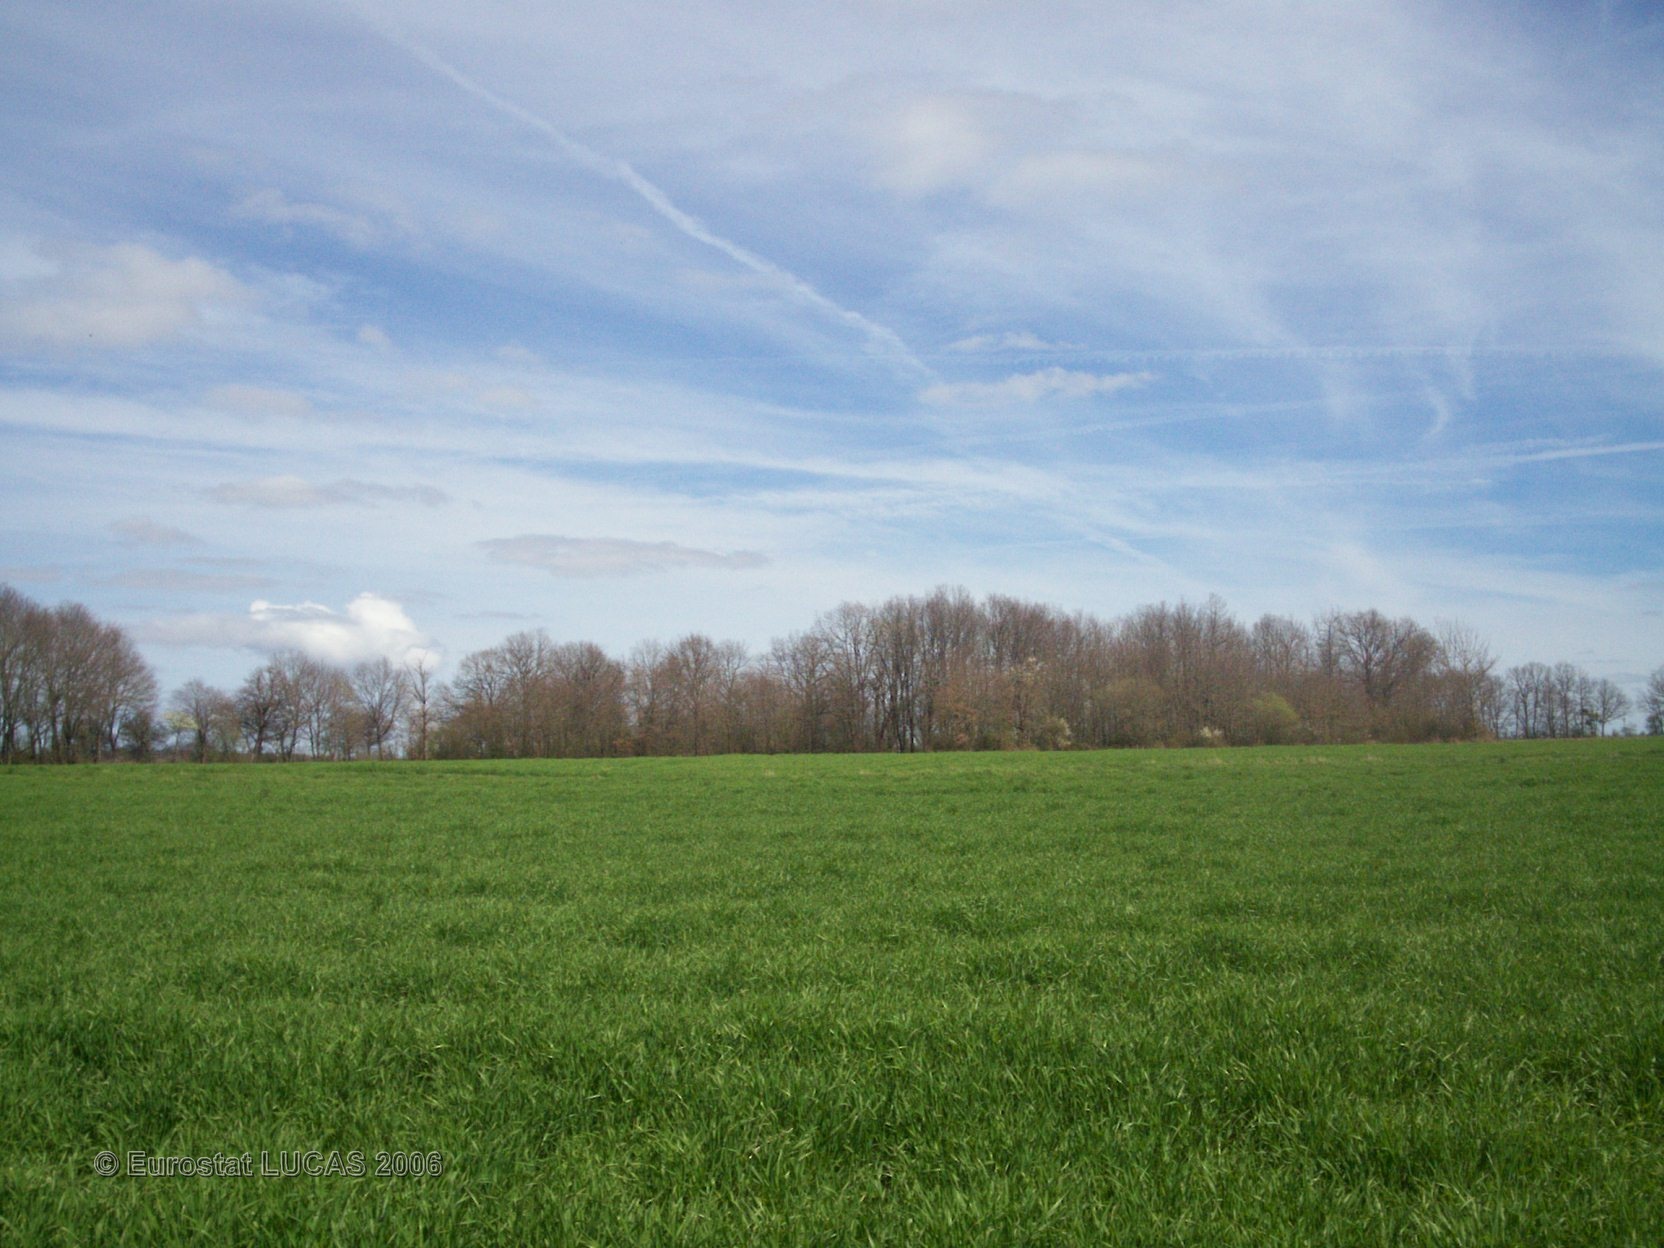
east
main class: Cropland
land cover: Barley
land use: Agriculture (excluding fallow land and kitchen gardens)
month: April
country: FR
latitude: 46.4347
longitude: 0.4951
